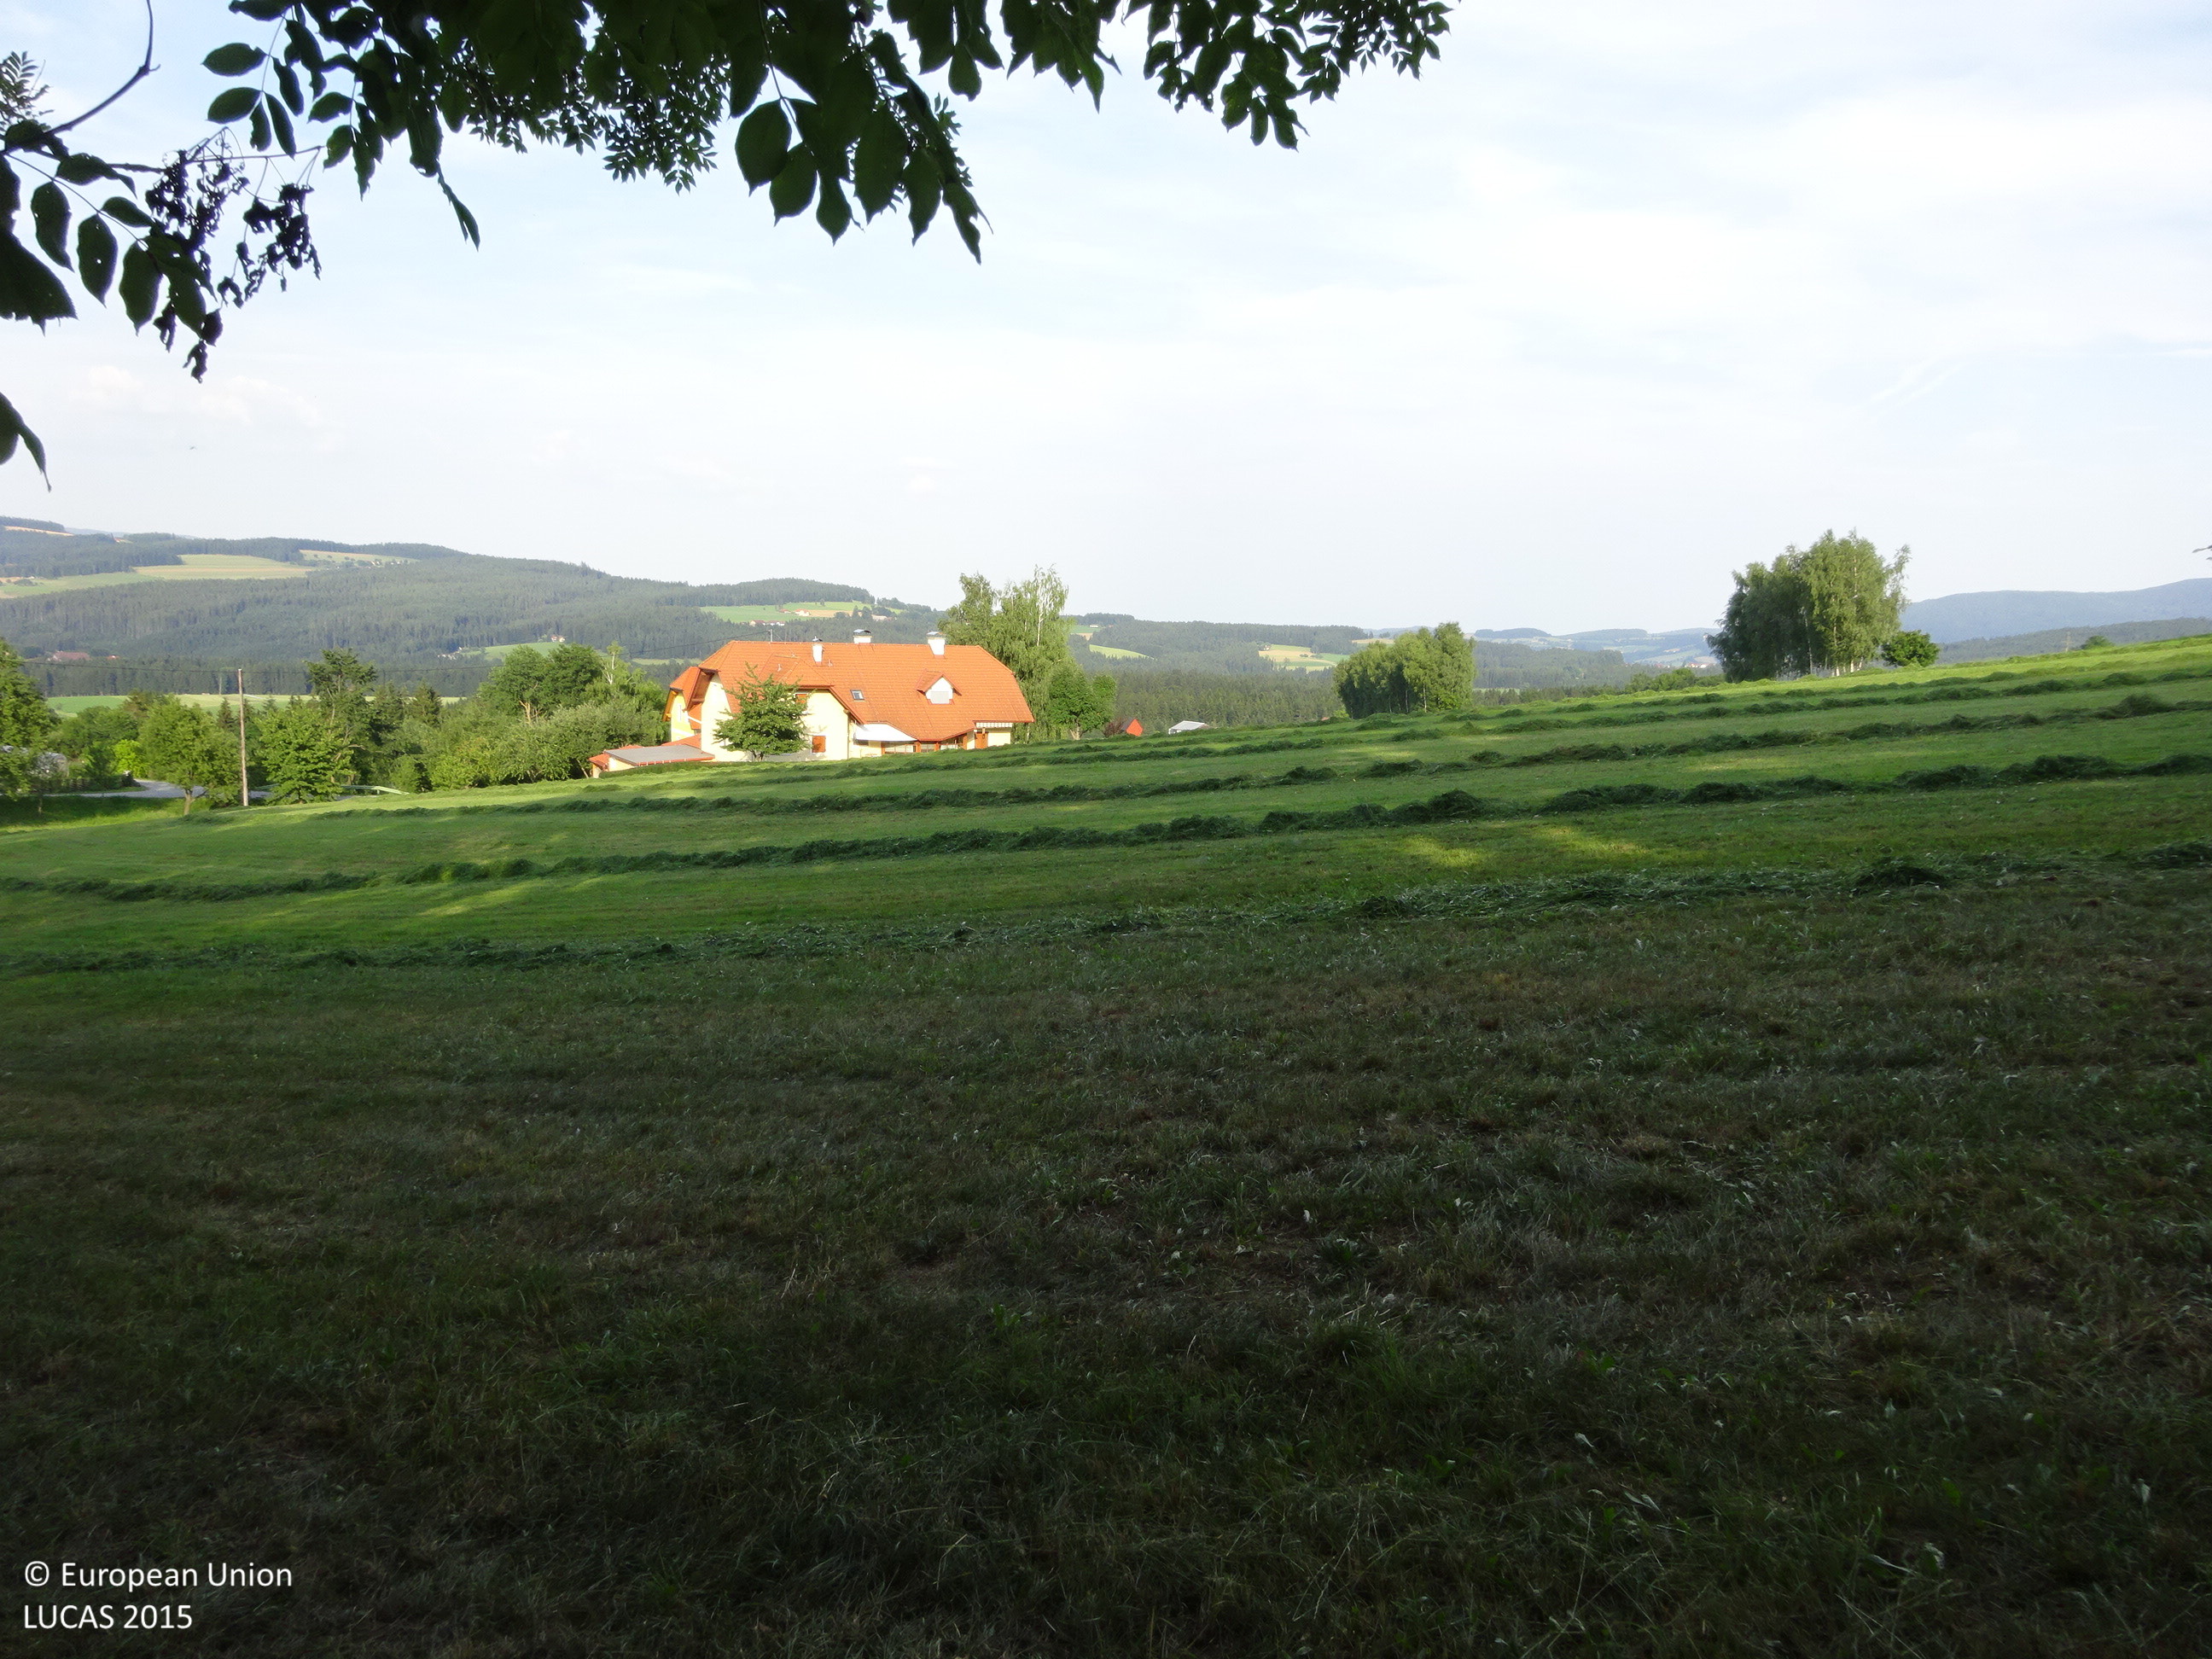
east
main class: Woodland
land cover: Broadleaved woodland
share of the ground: 50 - 75 %
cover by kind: broadleaved forest trees 50 %, herbaceous plants 50 %
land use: Semi-natural and natural areas not in use
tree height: > 5 m
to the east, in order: Broadleaved woodland; Grassland without tree/shrub cover; Ditches and canals; Grassland without tree/shrub cover; Artificial constructions in urban areas; Managed hedges; Grassland without tree/shrub cover
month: August
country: AT
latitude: 47.4037
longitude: 15.7921
